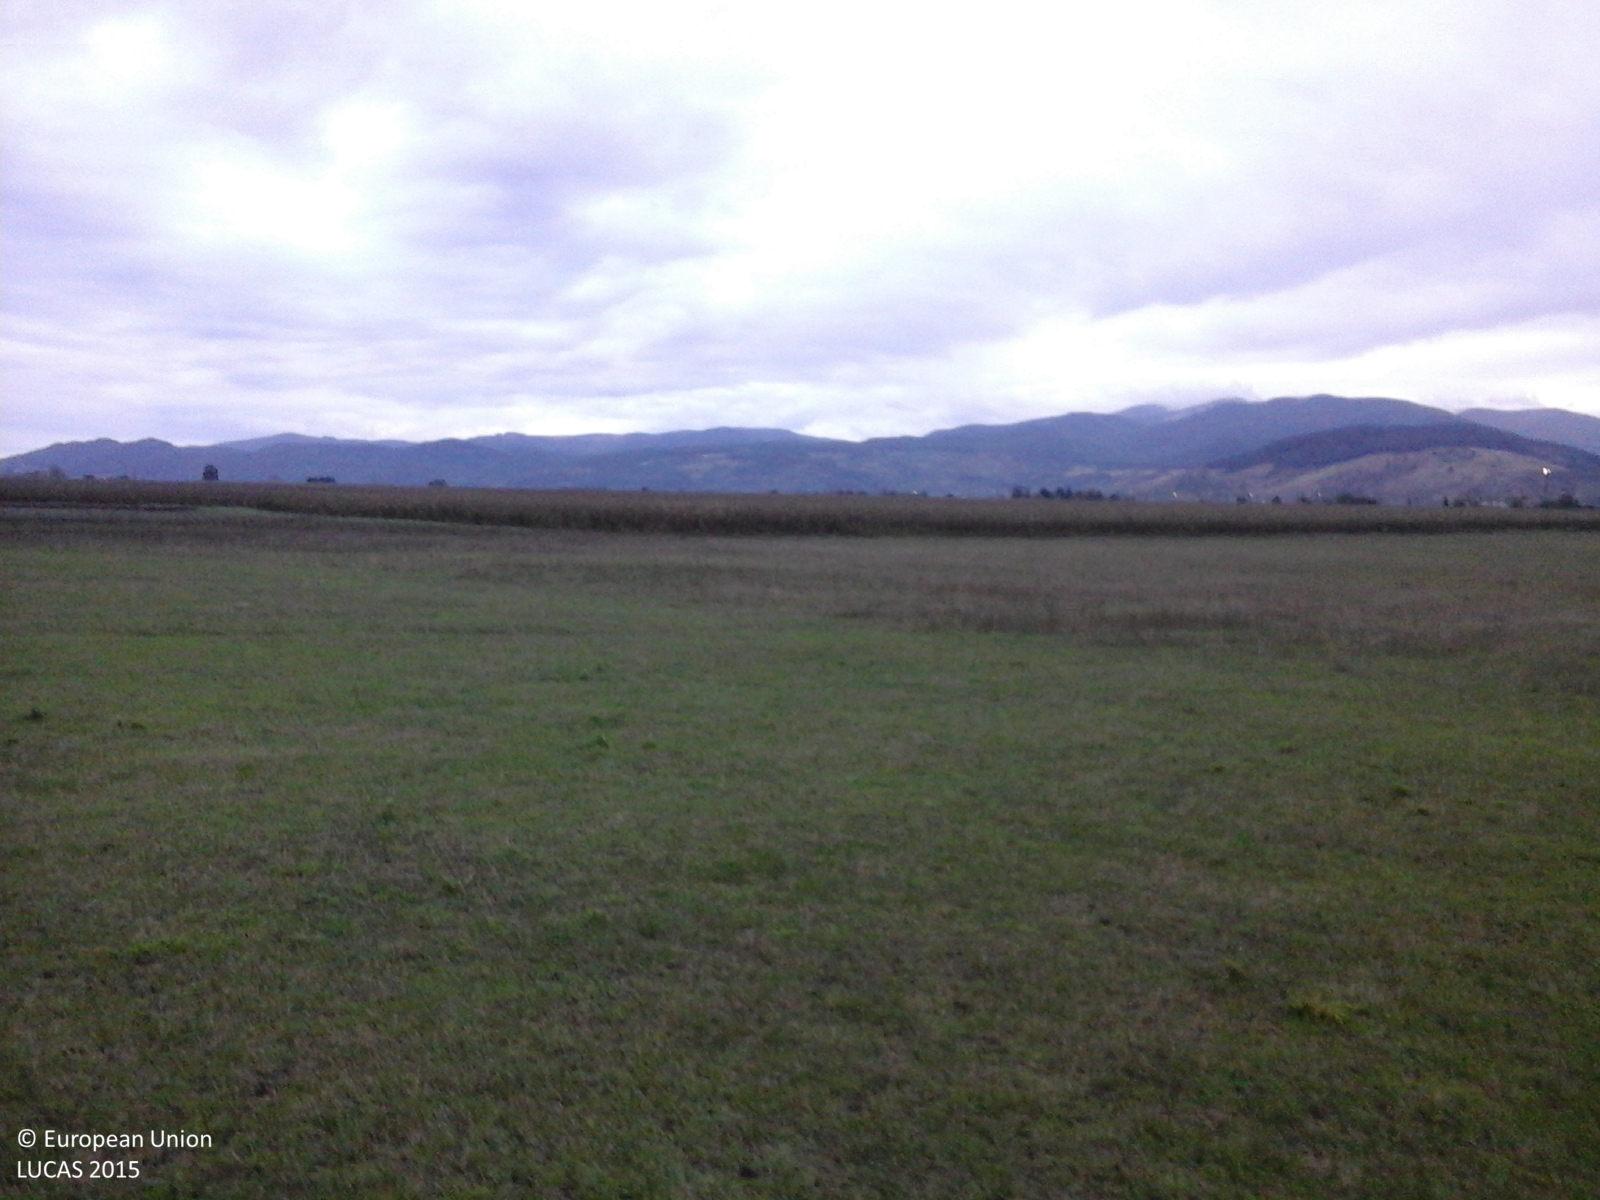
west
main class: Grassland
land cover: Grassland without tree/shrub cover
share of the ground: > 75 %
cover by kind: herbaceous plants 100 %
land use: Agriculture (excluding fallow land and kitchen gardens)
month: September
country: RO
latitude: 45.9832
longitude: 23.5022
